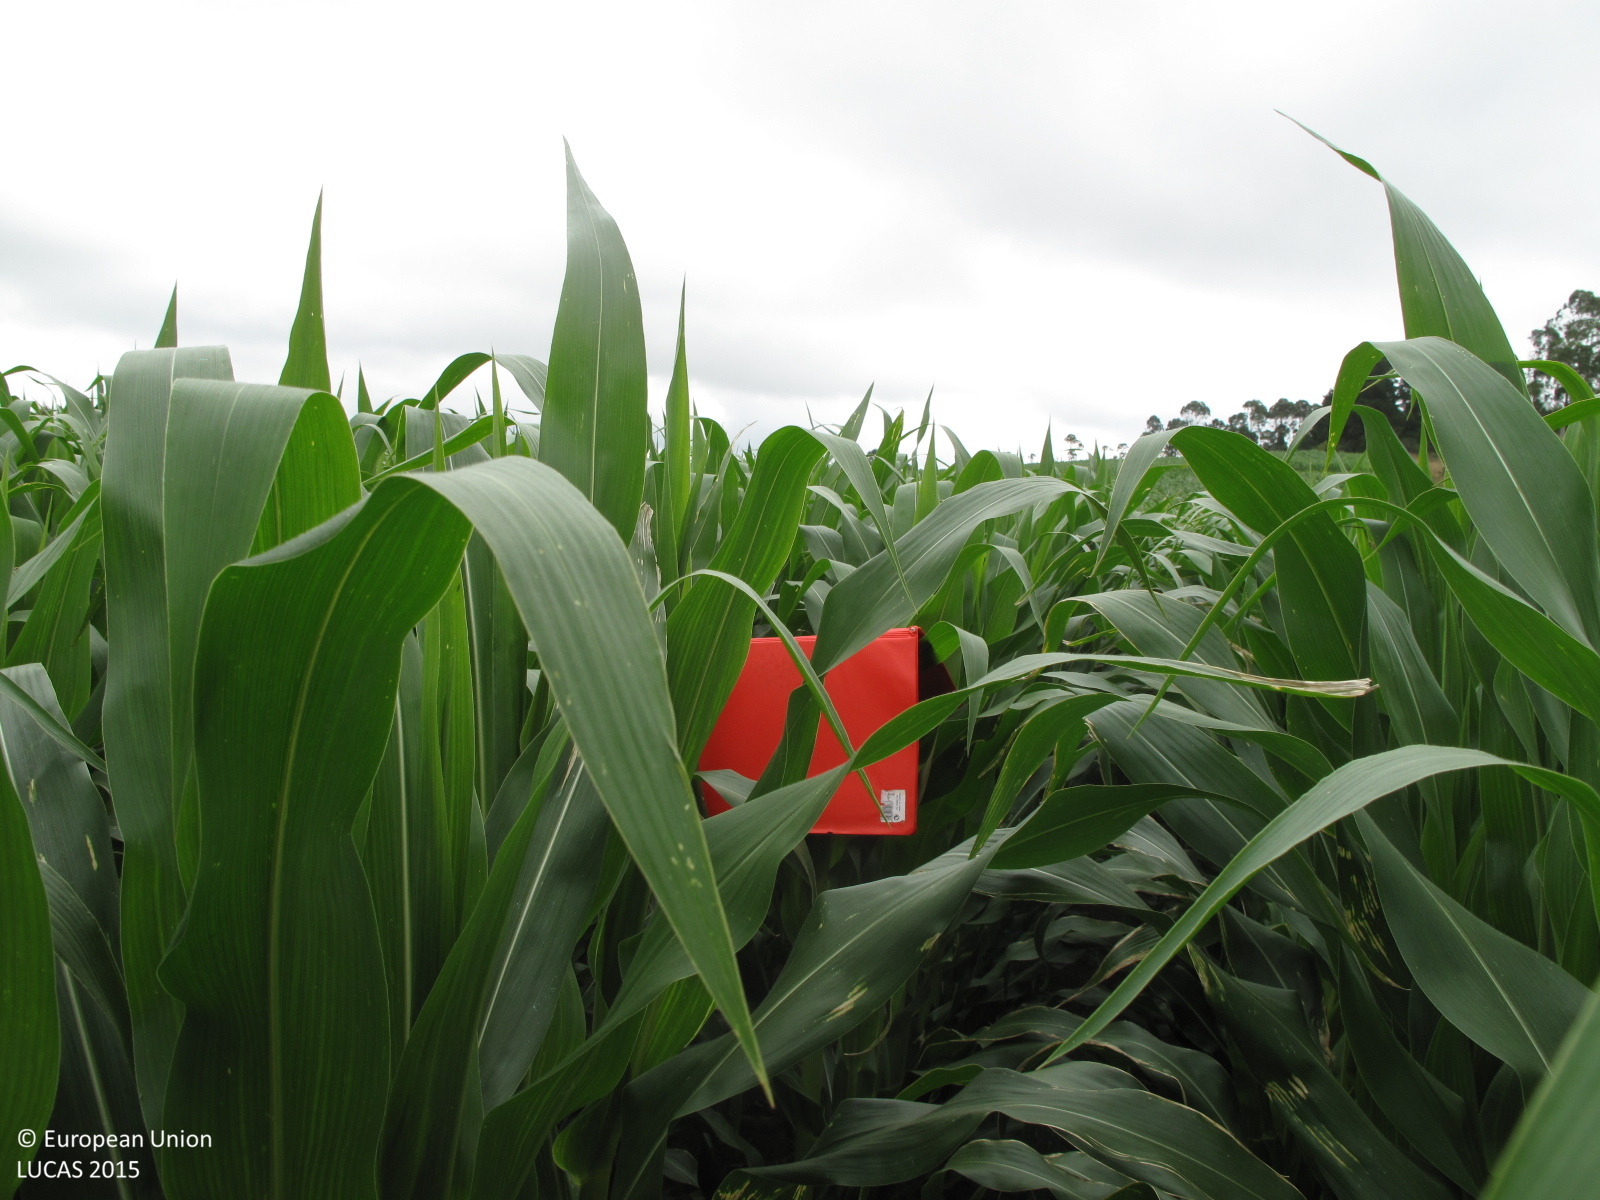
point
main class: Cropland
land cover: Maize
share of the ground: > 75 %
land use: Agriculture (excluding fallow land and kitchen gardens)
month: July
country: ES
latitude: 43.0989
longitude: -8.1695
